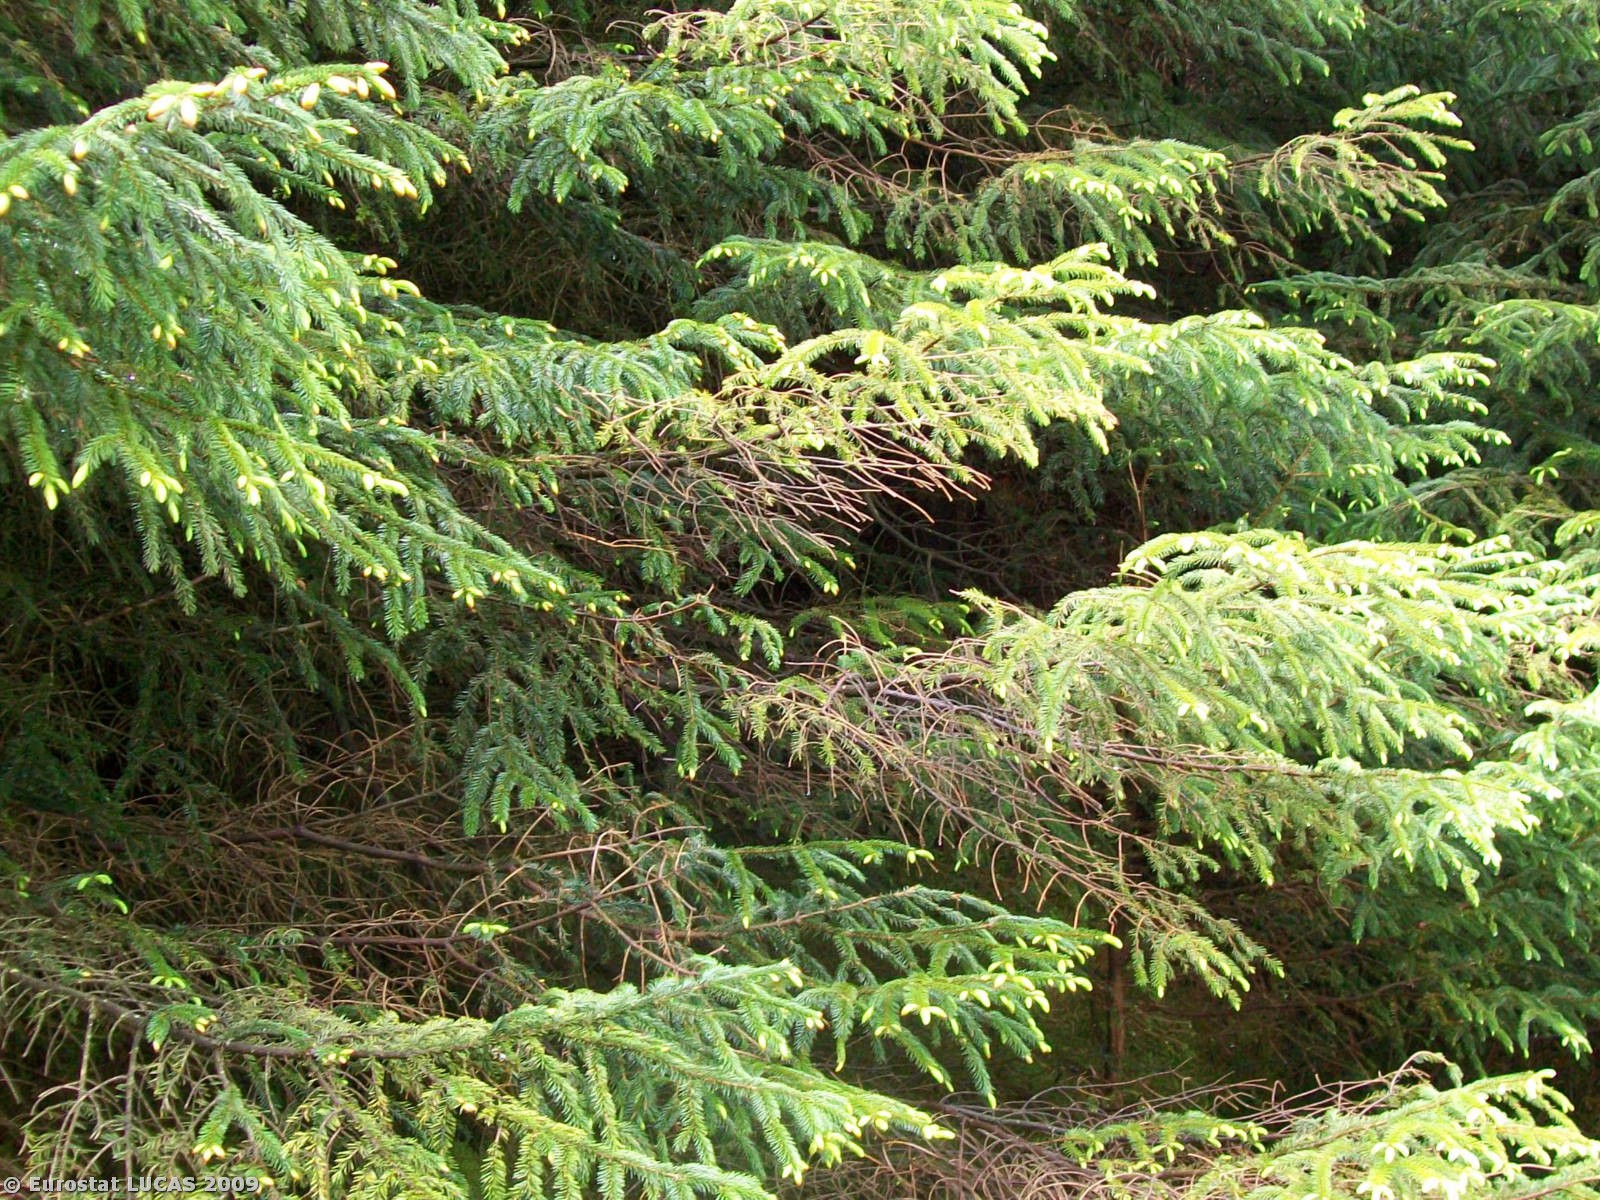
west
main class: Woodland
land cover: Coniferous woodland
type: plantations and self-sown exotic forest
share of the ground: > 75 %
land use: Forestry
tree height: > 5 m
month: May
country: GB
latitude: 51.9090
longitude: -3.6795
